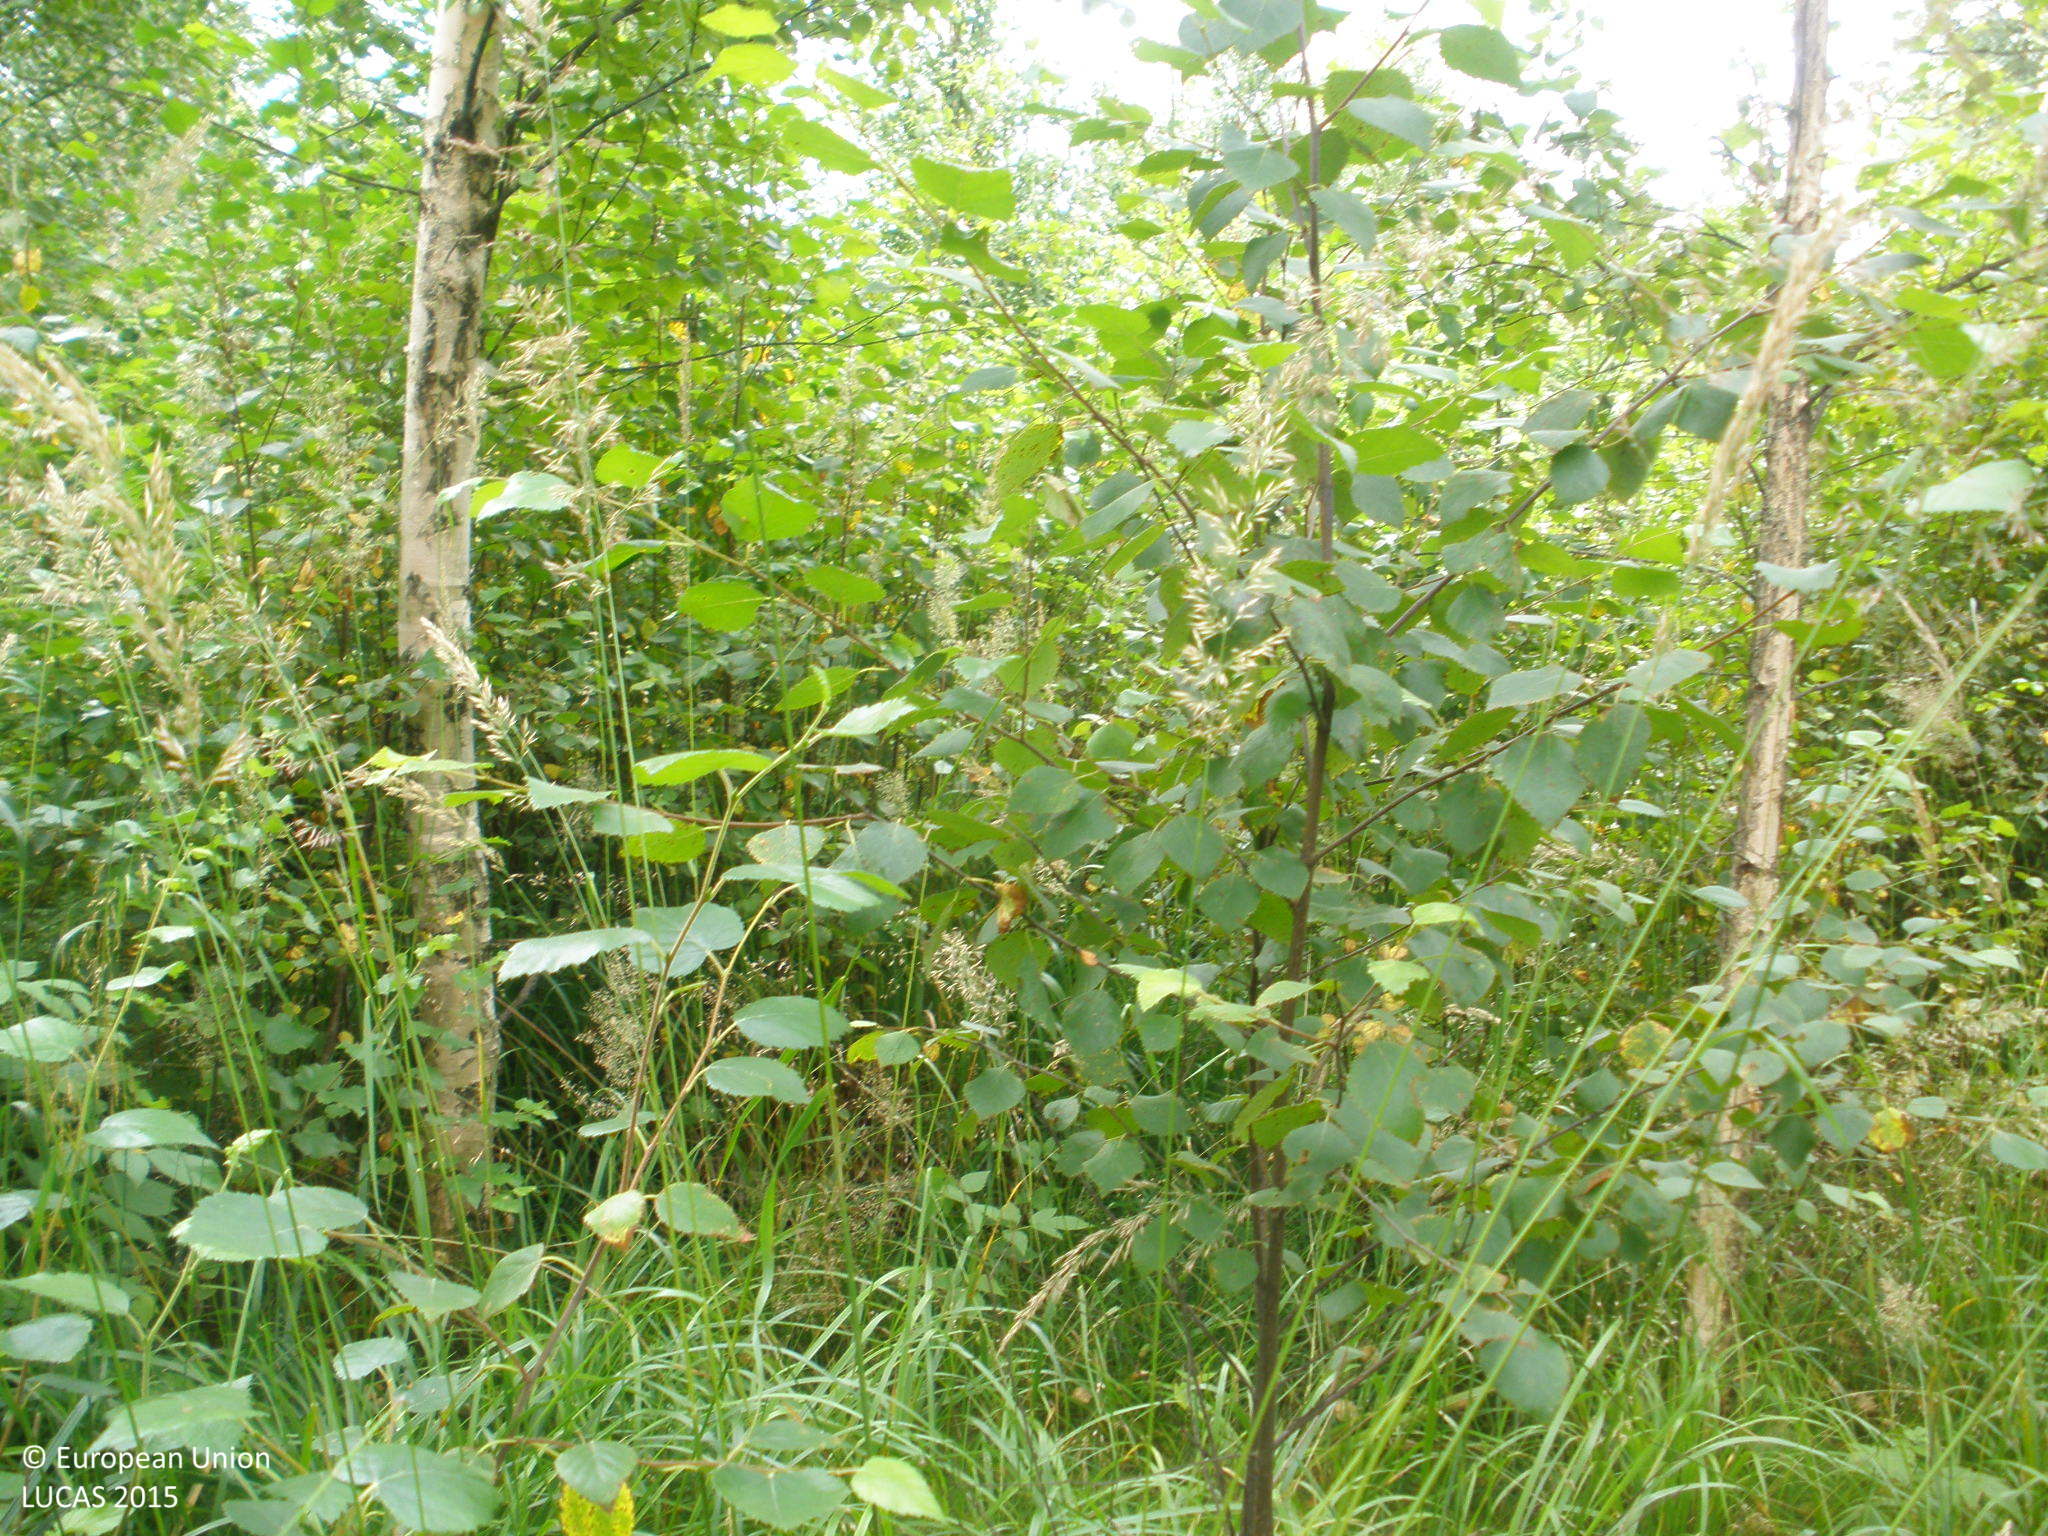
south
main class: Woodland
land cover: Broadleaved woodland
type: boreal forest
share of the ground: > 75 %
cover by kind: broadleaved forest trees 80 %, herbaceous plants 10 %, coniferous forest trees 5 %, shrubs 5 %
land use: Forestry
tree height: > 5 m
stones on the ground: 10 - 25 %
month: August
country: FI
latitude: 60.6212
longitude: 24.1134
